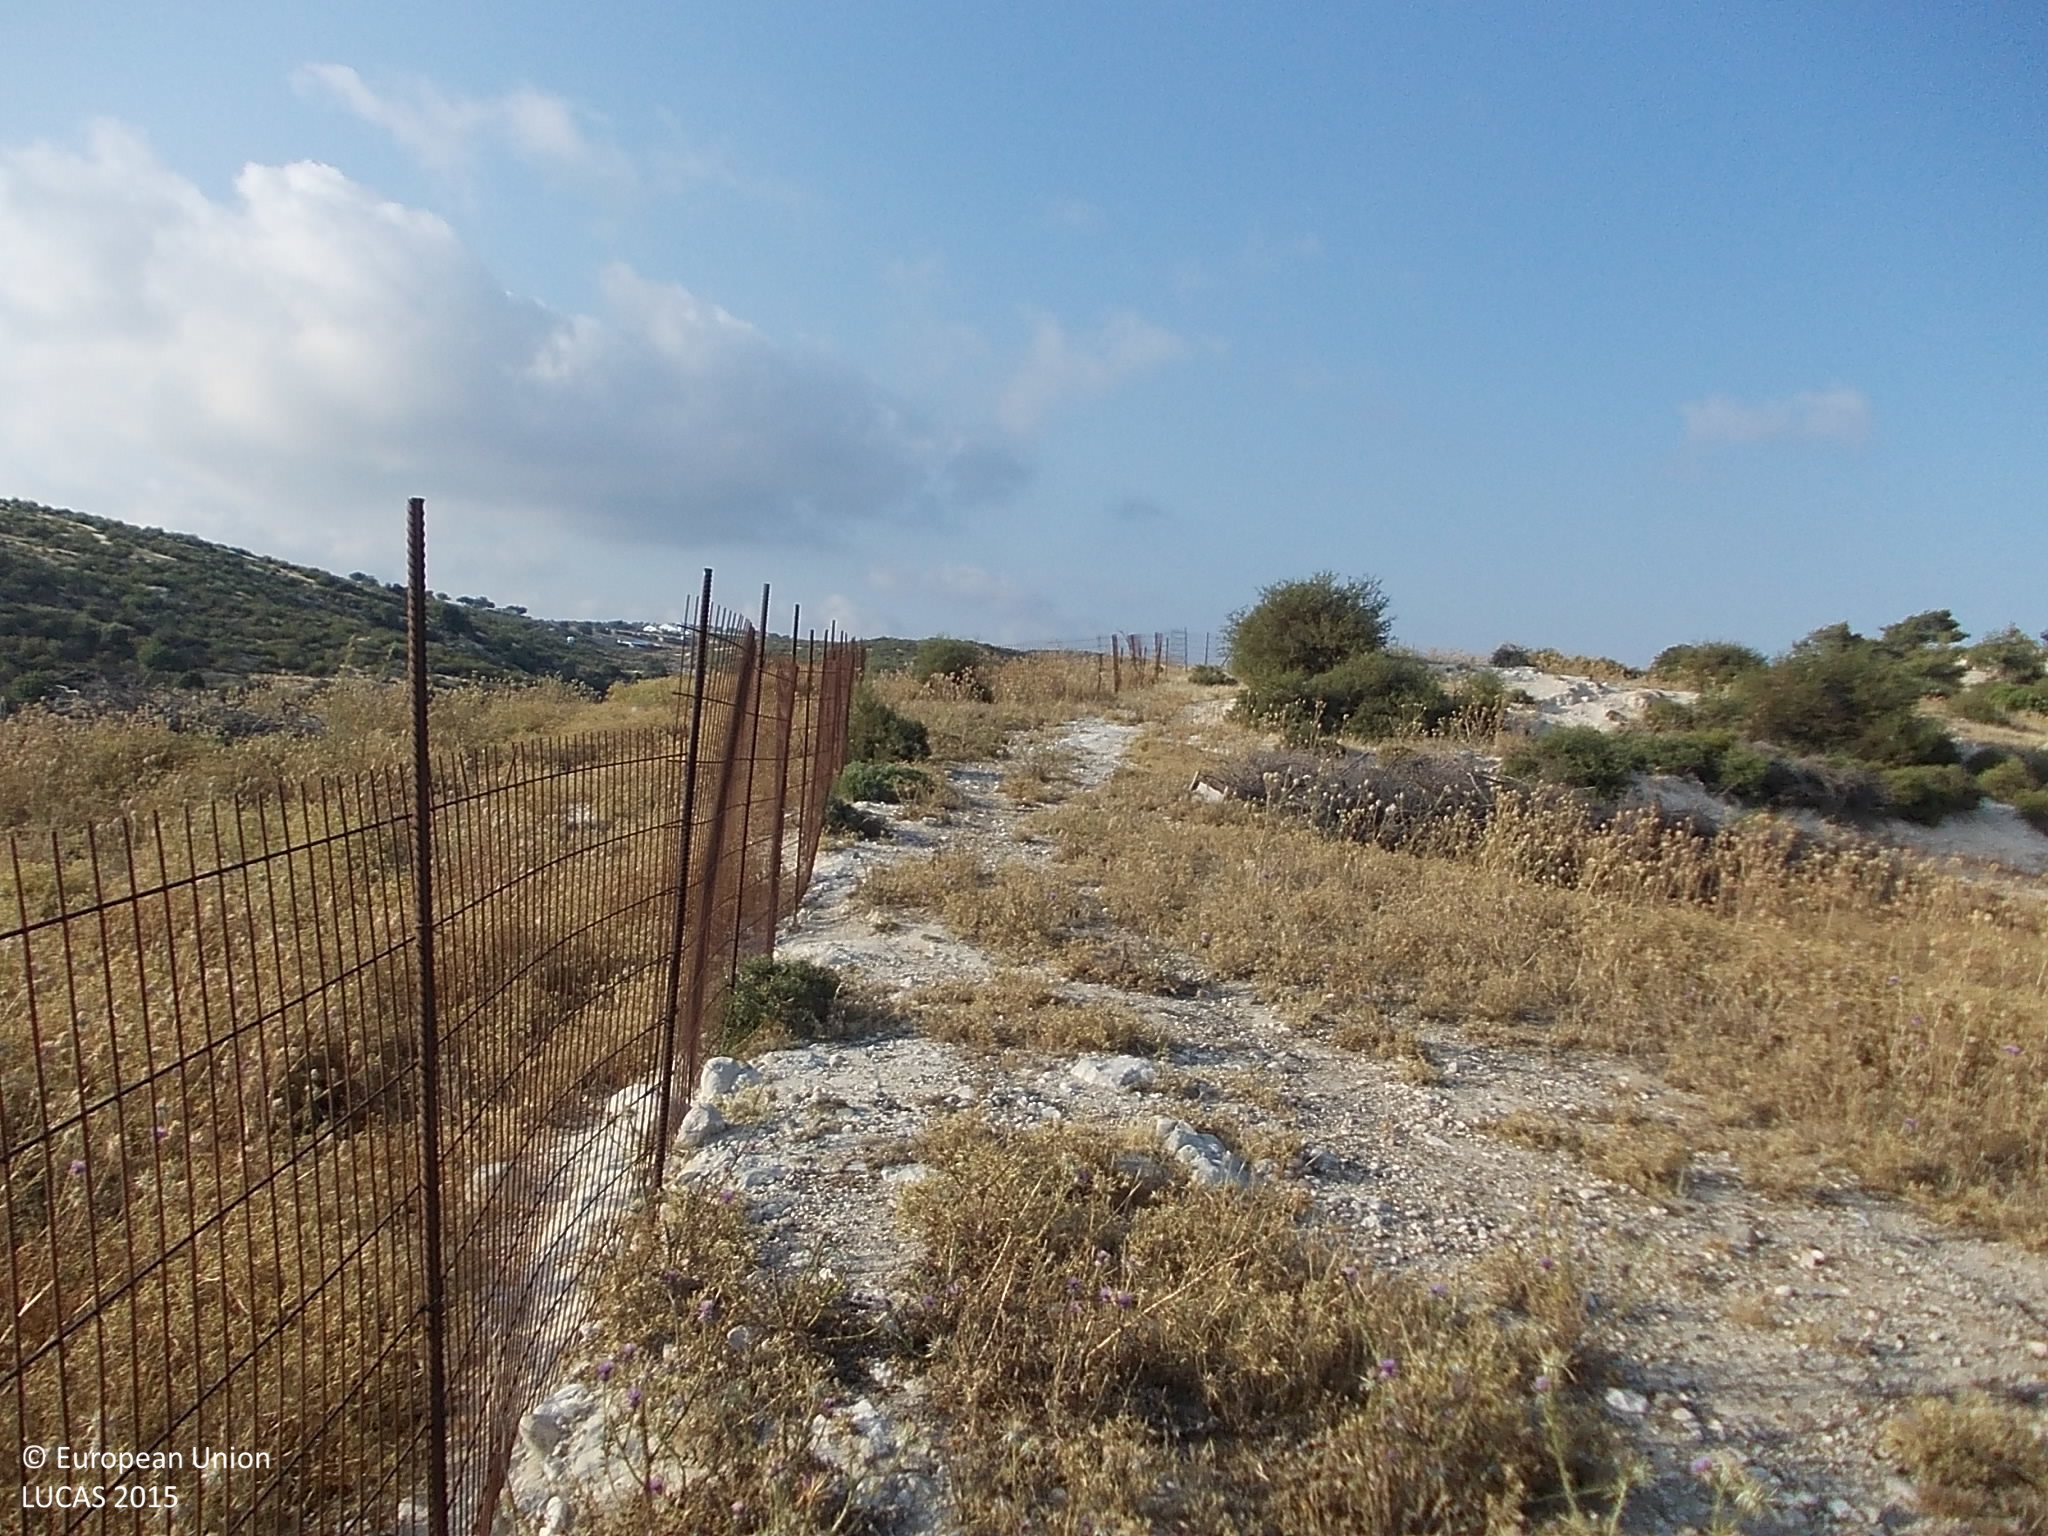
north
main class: Grassland
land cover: Grassland without tree/shrub cover
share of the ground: > 75 %
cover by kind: herbaceous plants 85 %, unconsolidated bare surface 15 %
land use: Logistics and storage
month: June
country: CY
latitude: 34.6850
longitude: 32.6912
